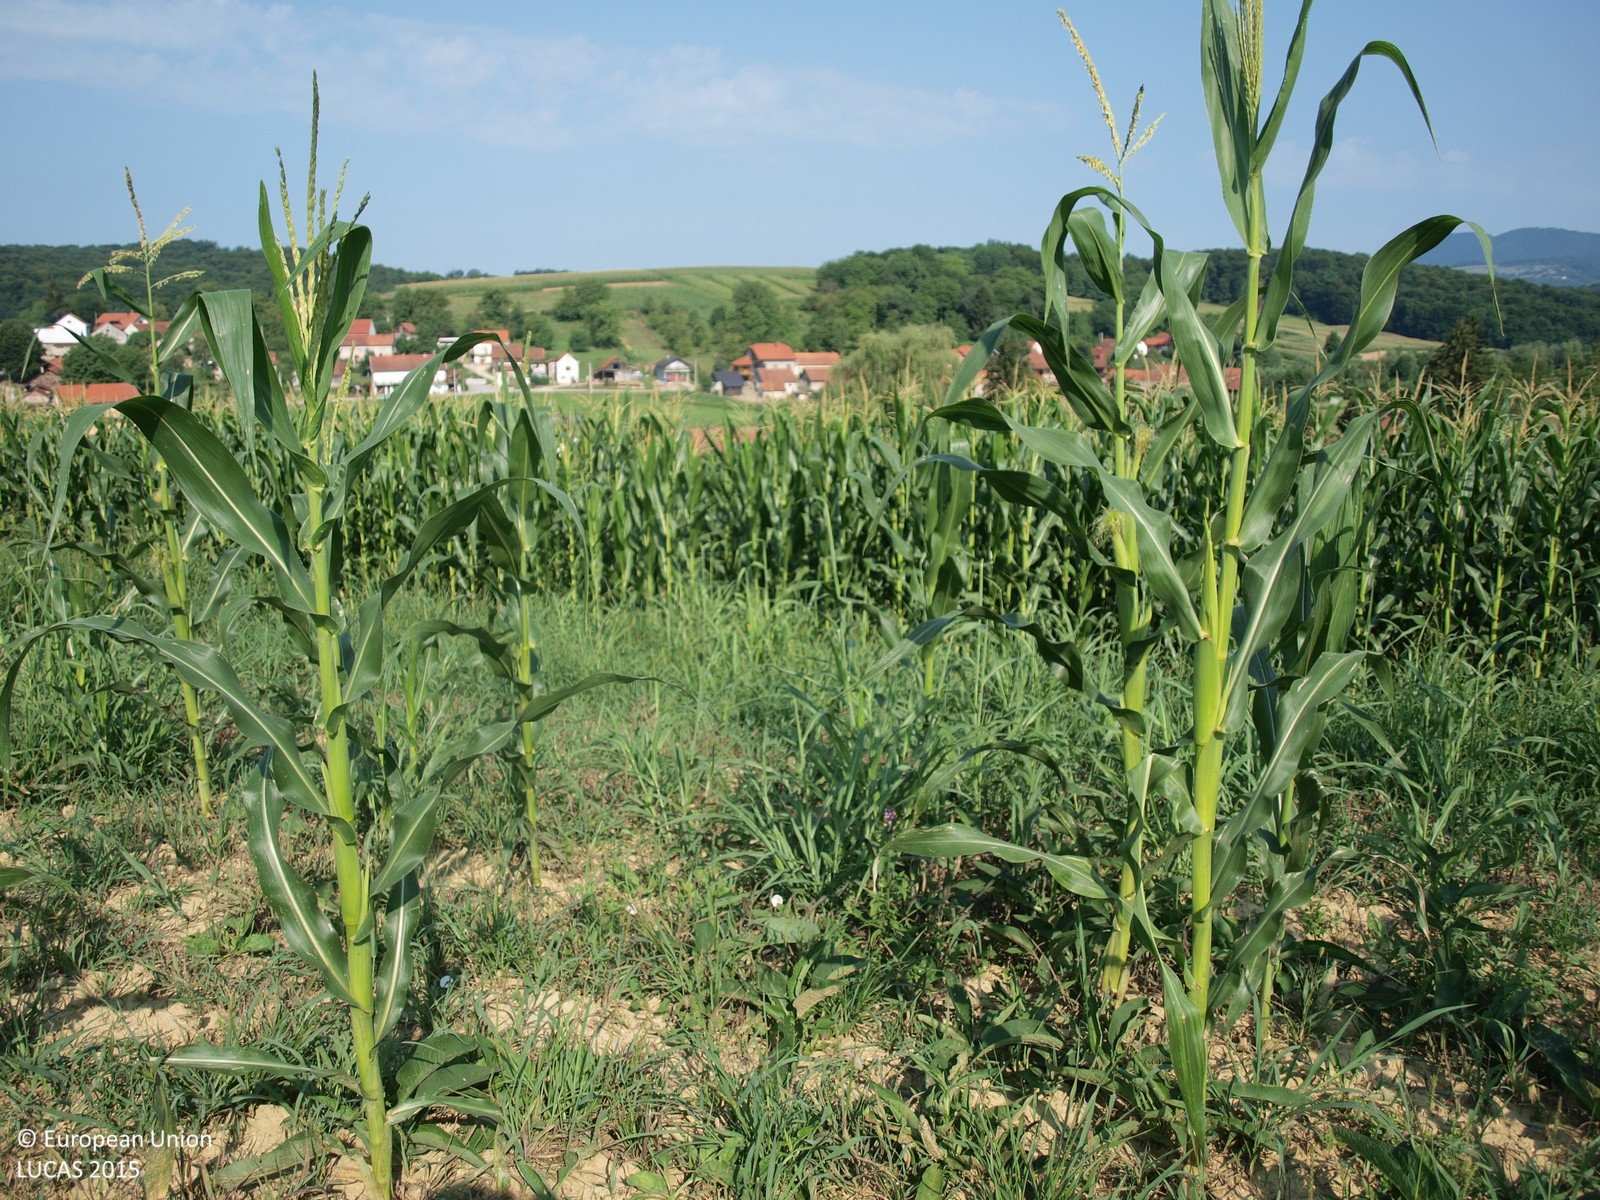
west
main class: Cropland
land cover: Maize
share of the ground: 10 - 25 %
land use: Agriculture (excluding fallow land and kitchen gardens)
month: July
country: HR
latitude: 46.1320
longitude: 15.9396
